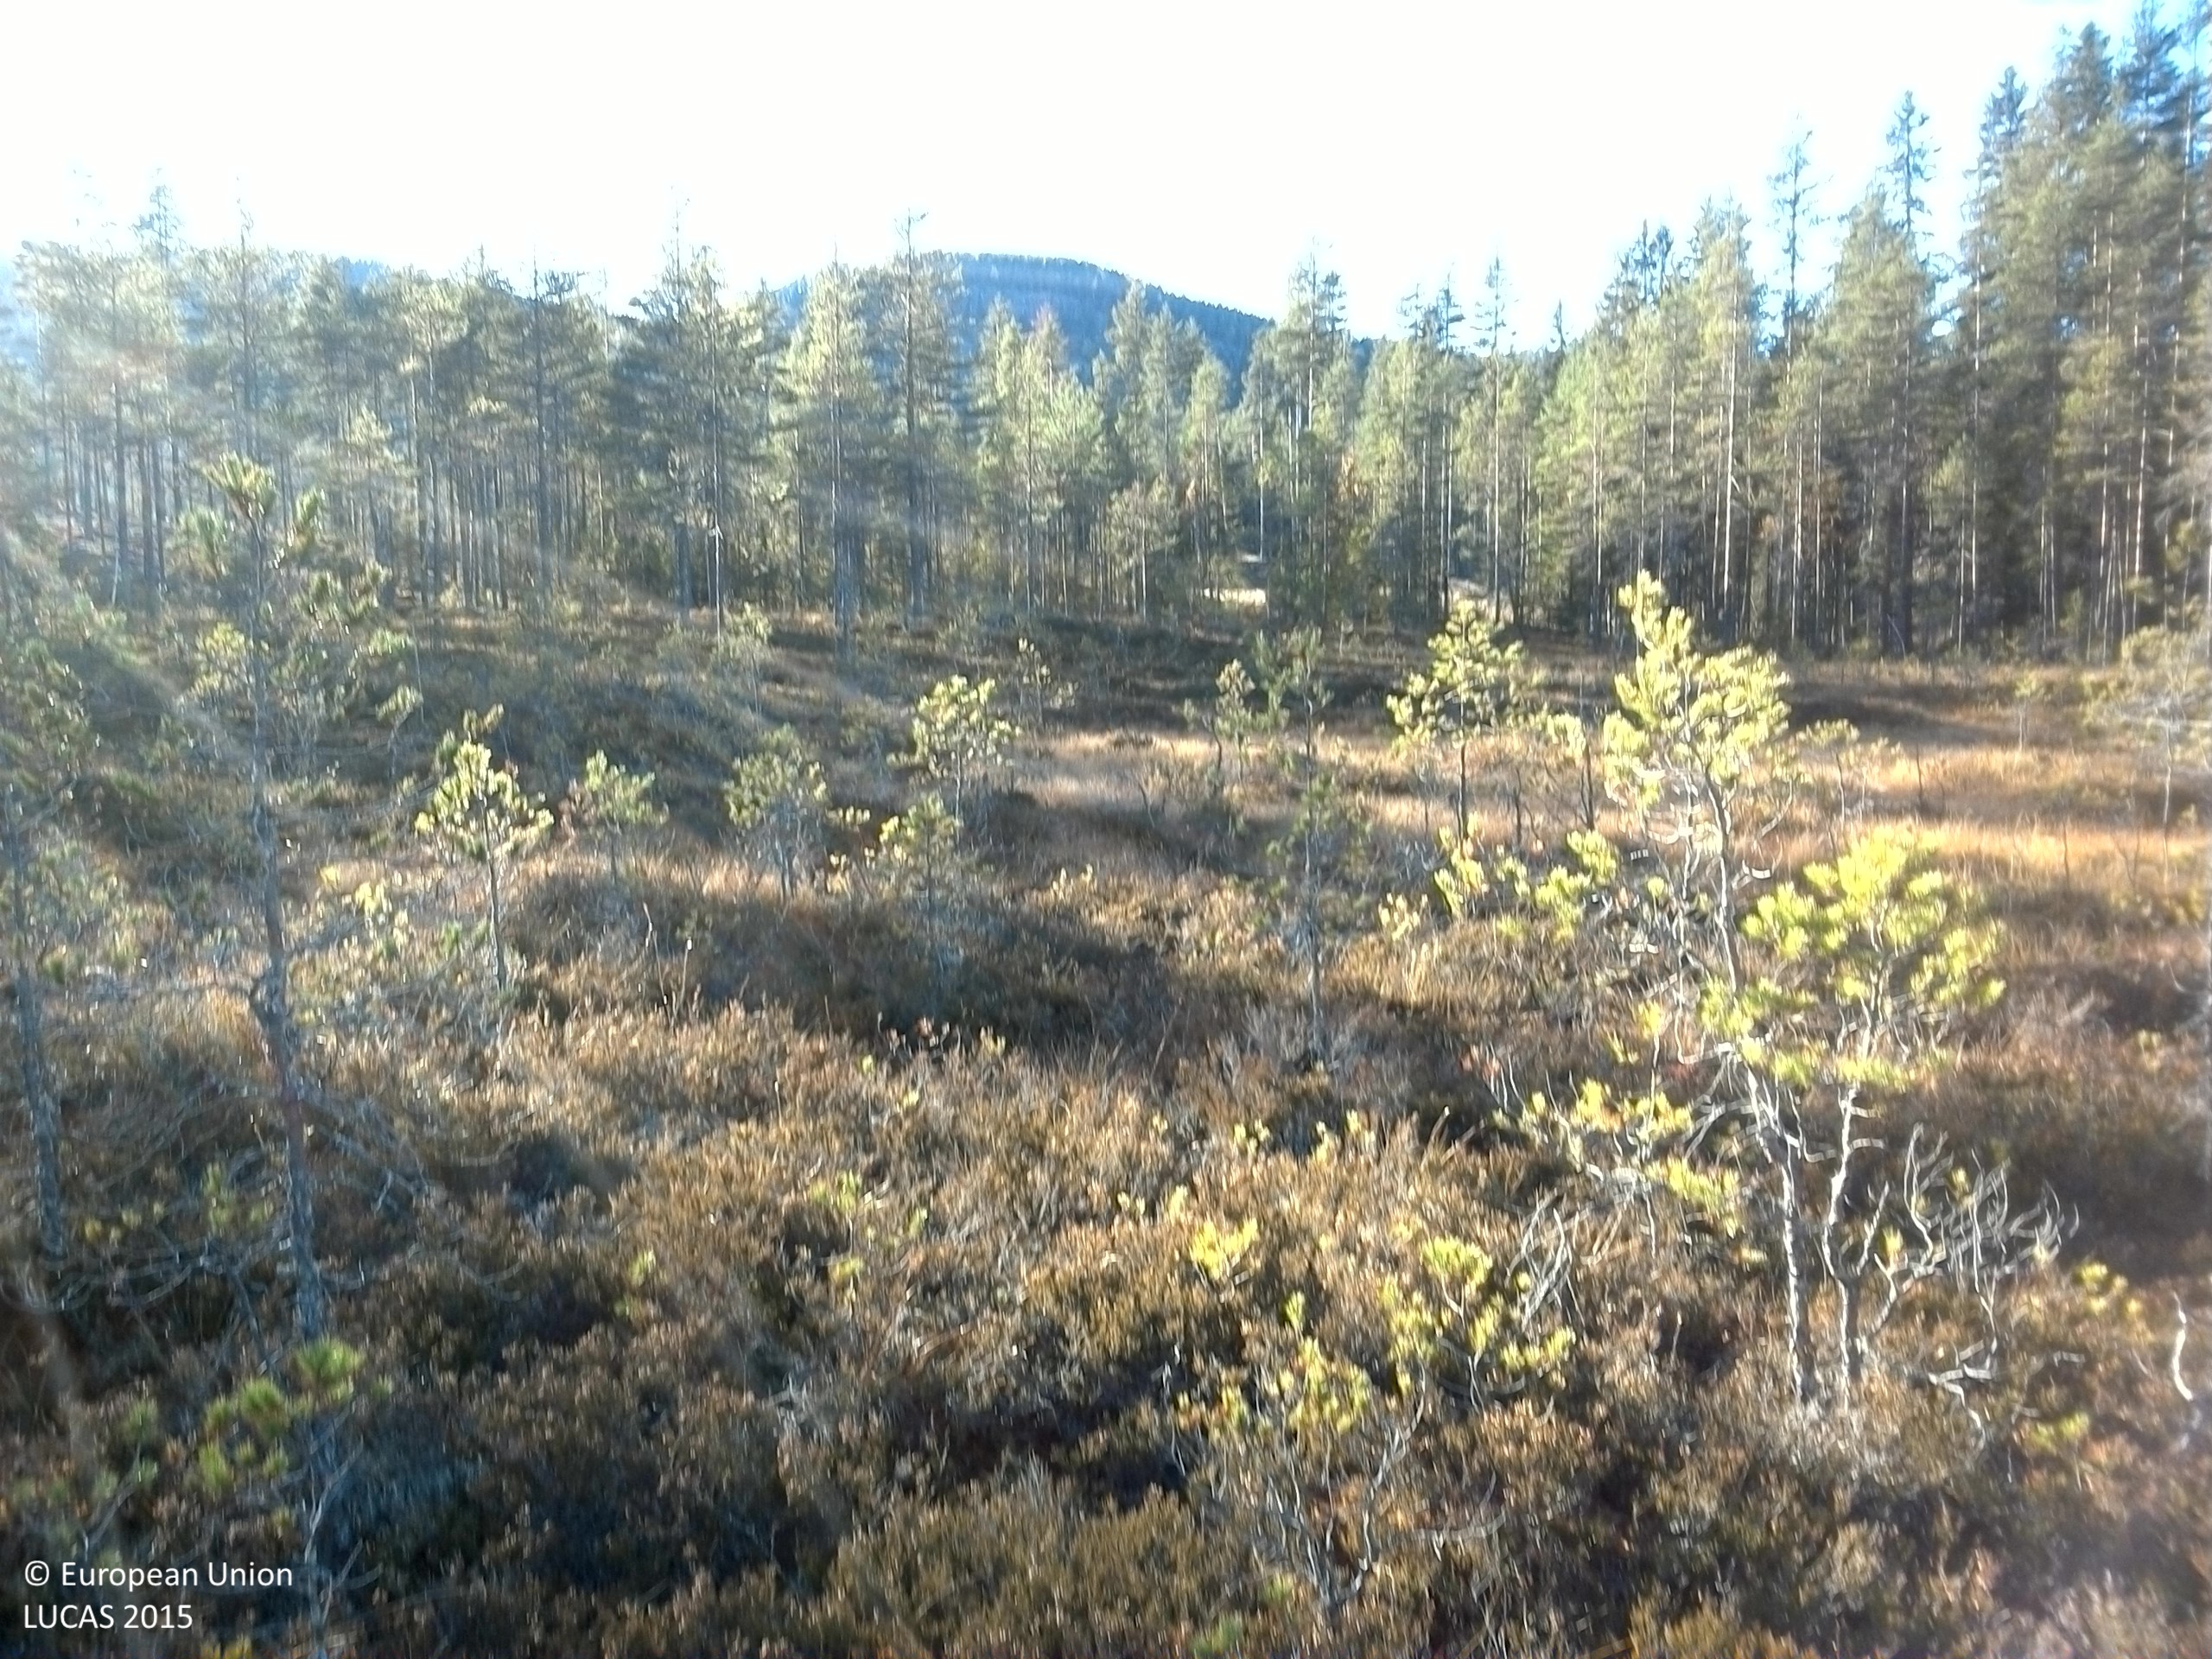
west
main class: Woodland
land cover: Pine dominated coniferous woodland
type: boreal forest
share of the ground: 10 - 25 %
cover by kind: lichens and mosses 40 %, shrubs 25 %, coniferous forest trees 20 %, herbaceous plants 15 %
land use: Semi-natural and natural areas not in use
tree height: < 5 m
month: October
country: SE
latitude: 61.1776
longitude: 14.3561
